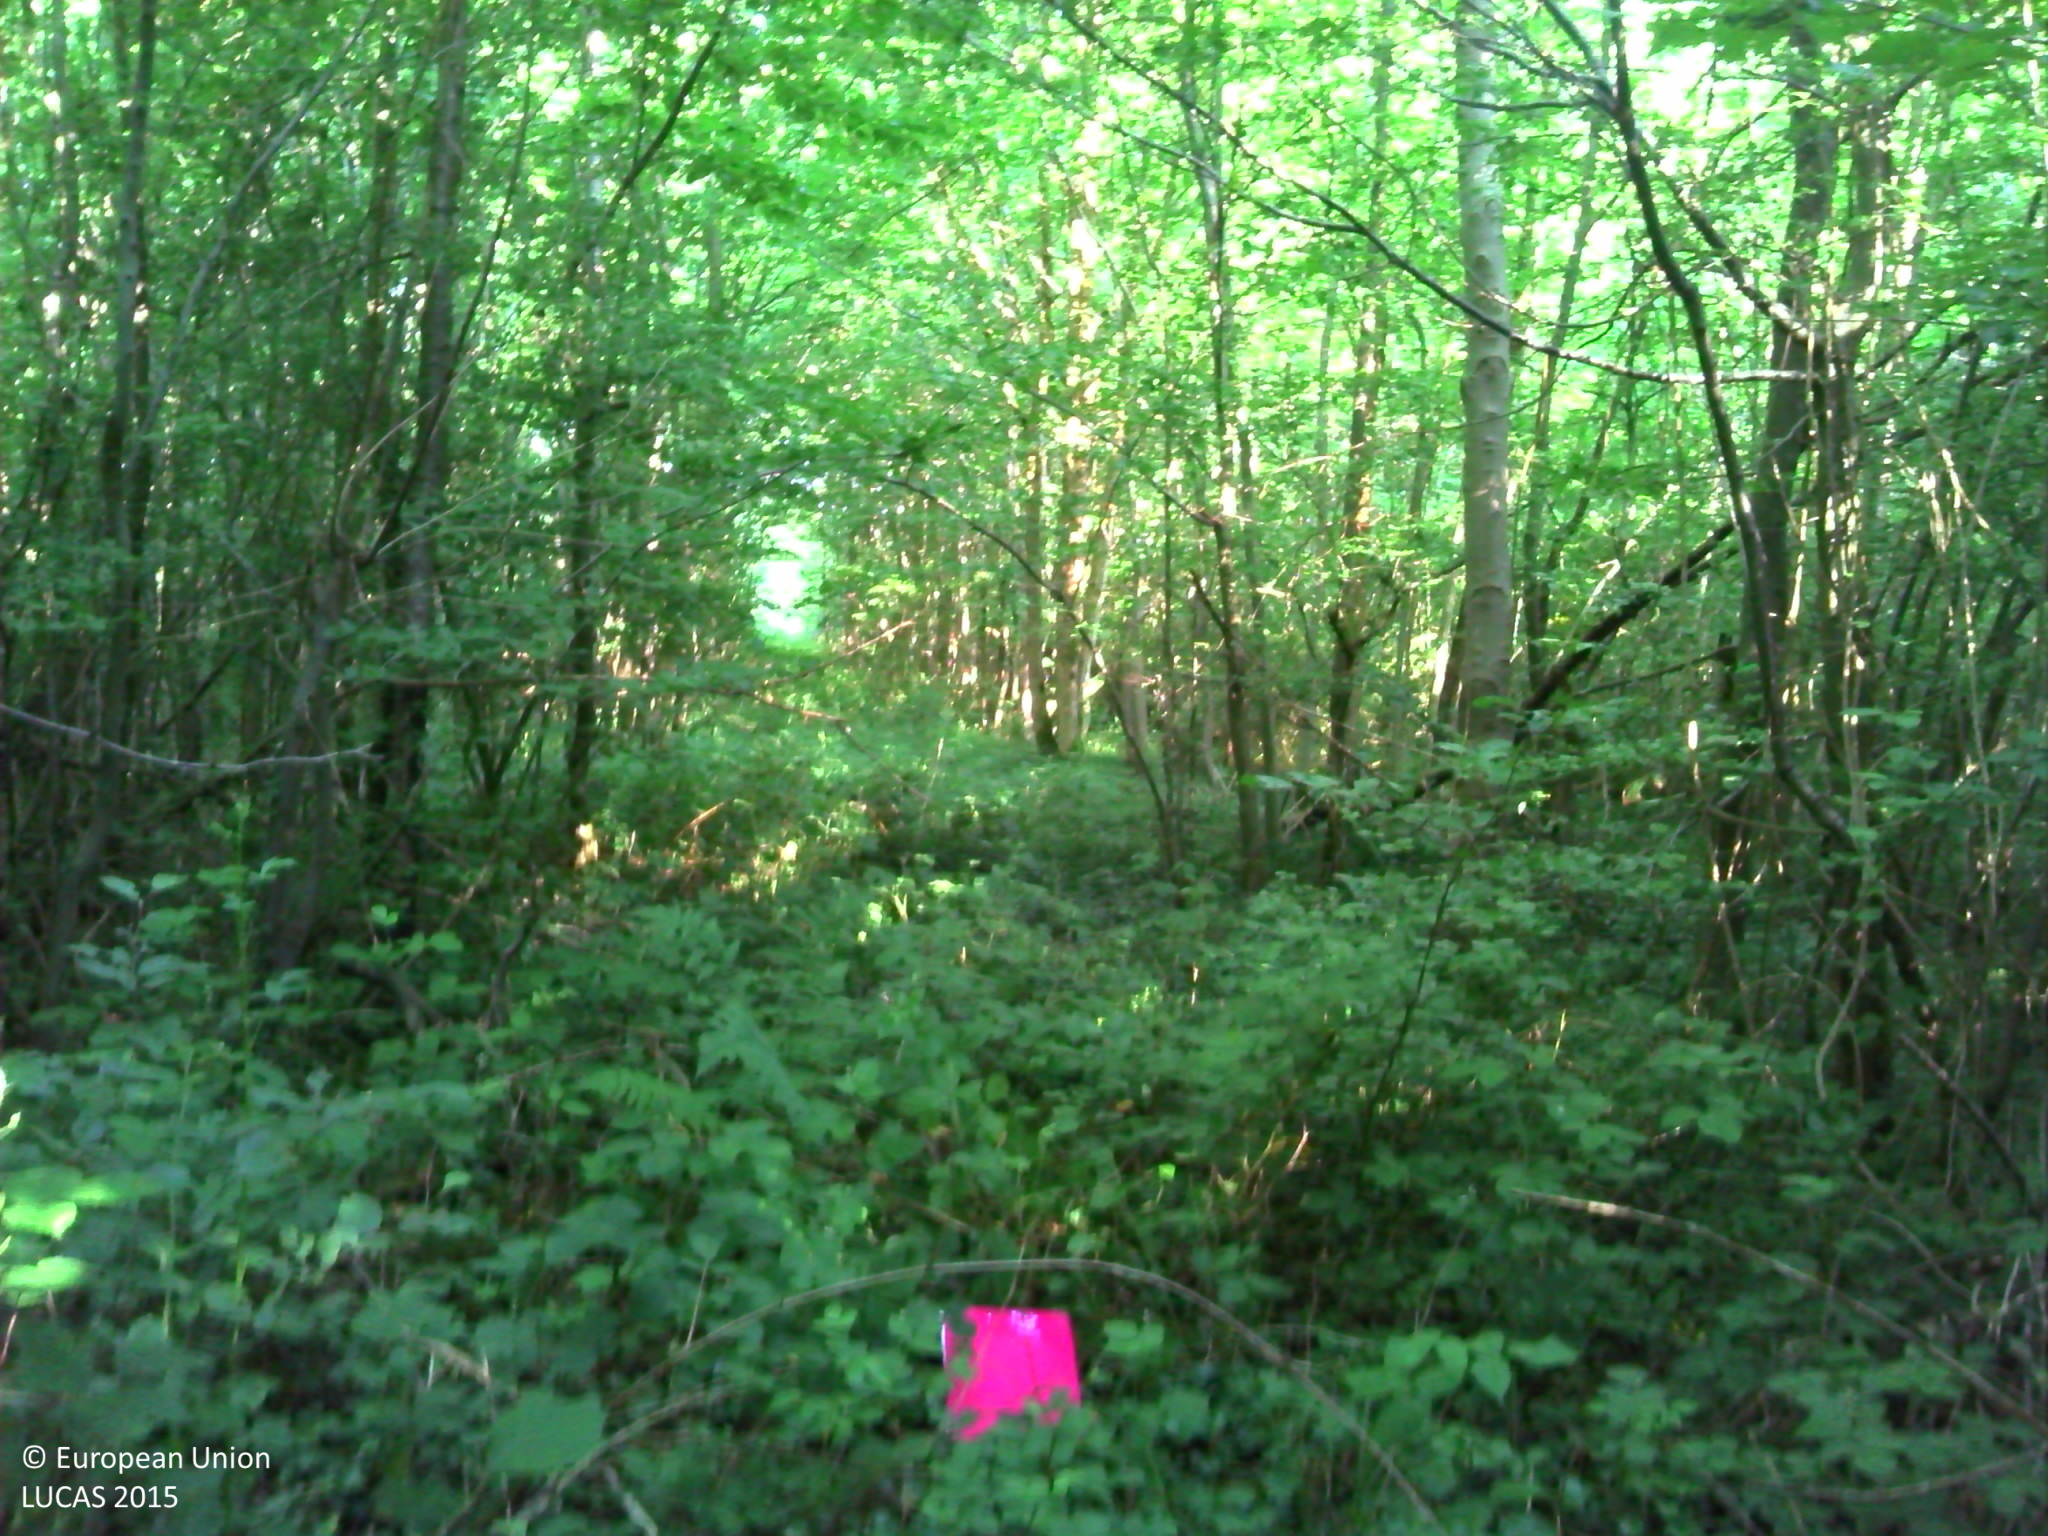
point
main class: Woodland
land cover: Broadleaved woodland
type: beech forest
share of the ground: > 75 %
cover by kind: broadleaved forest trees 85 %, shrubs 10 %, herbaceous plants 5 %
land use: Forestry
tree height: > 5 m
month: June
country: FR
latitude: 49.5458
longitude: 2.8721
